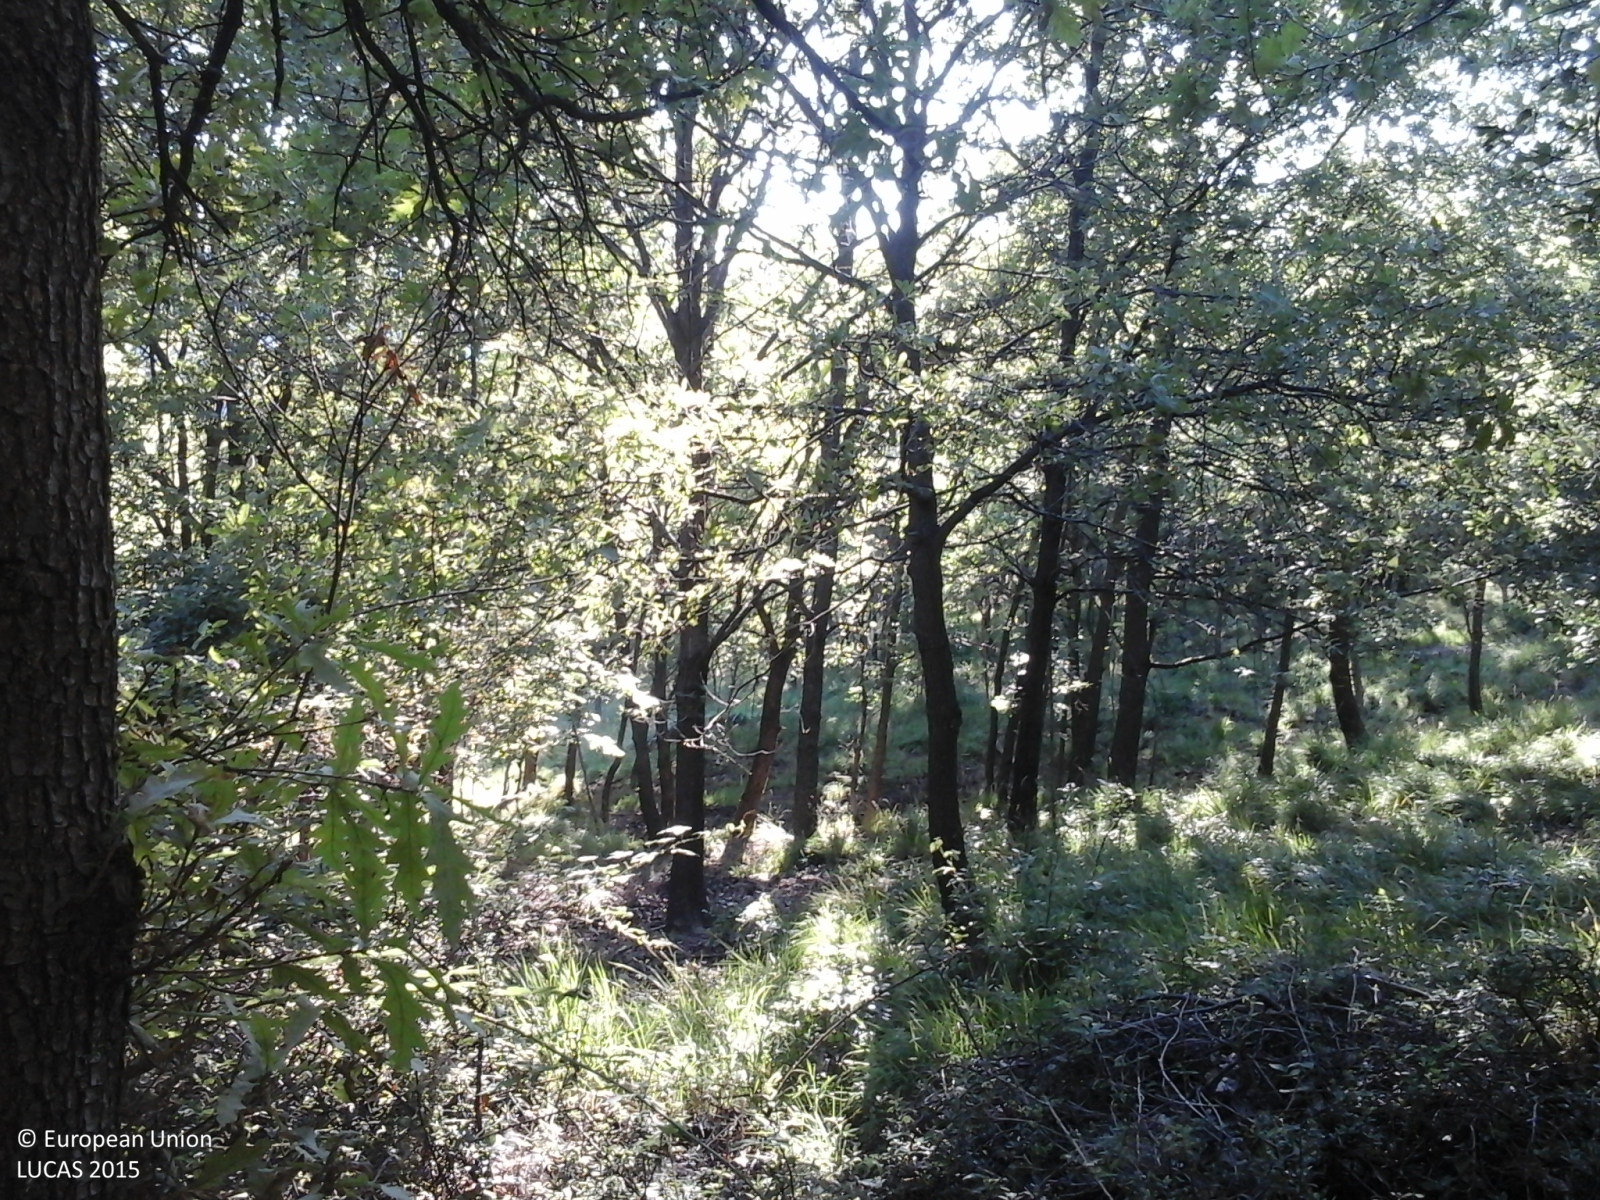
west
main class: Woodland
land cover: Broadleaved woodland
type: thermophilous deciduous forest
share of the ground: > 75 %
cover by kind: broadleaved forest trees 100 %
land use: Forestry
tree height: > 5 m
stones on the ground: < 10 %
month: June
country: IT
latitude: 44.6323
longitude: 8.8050
